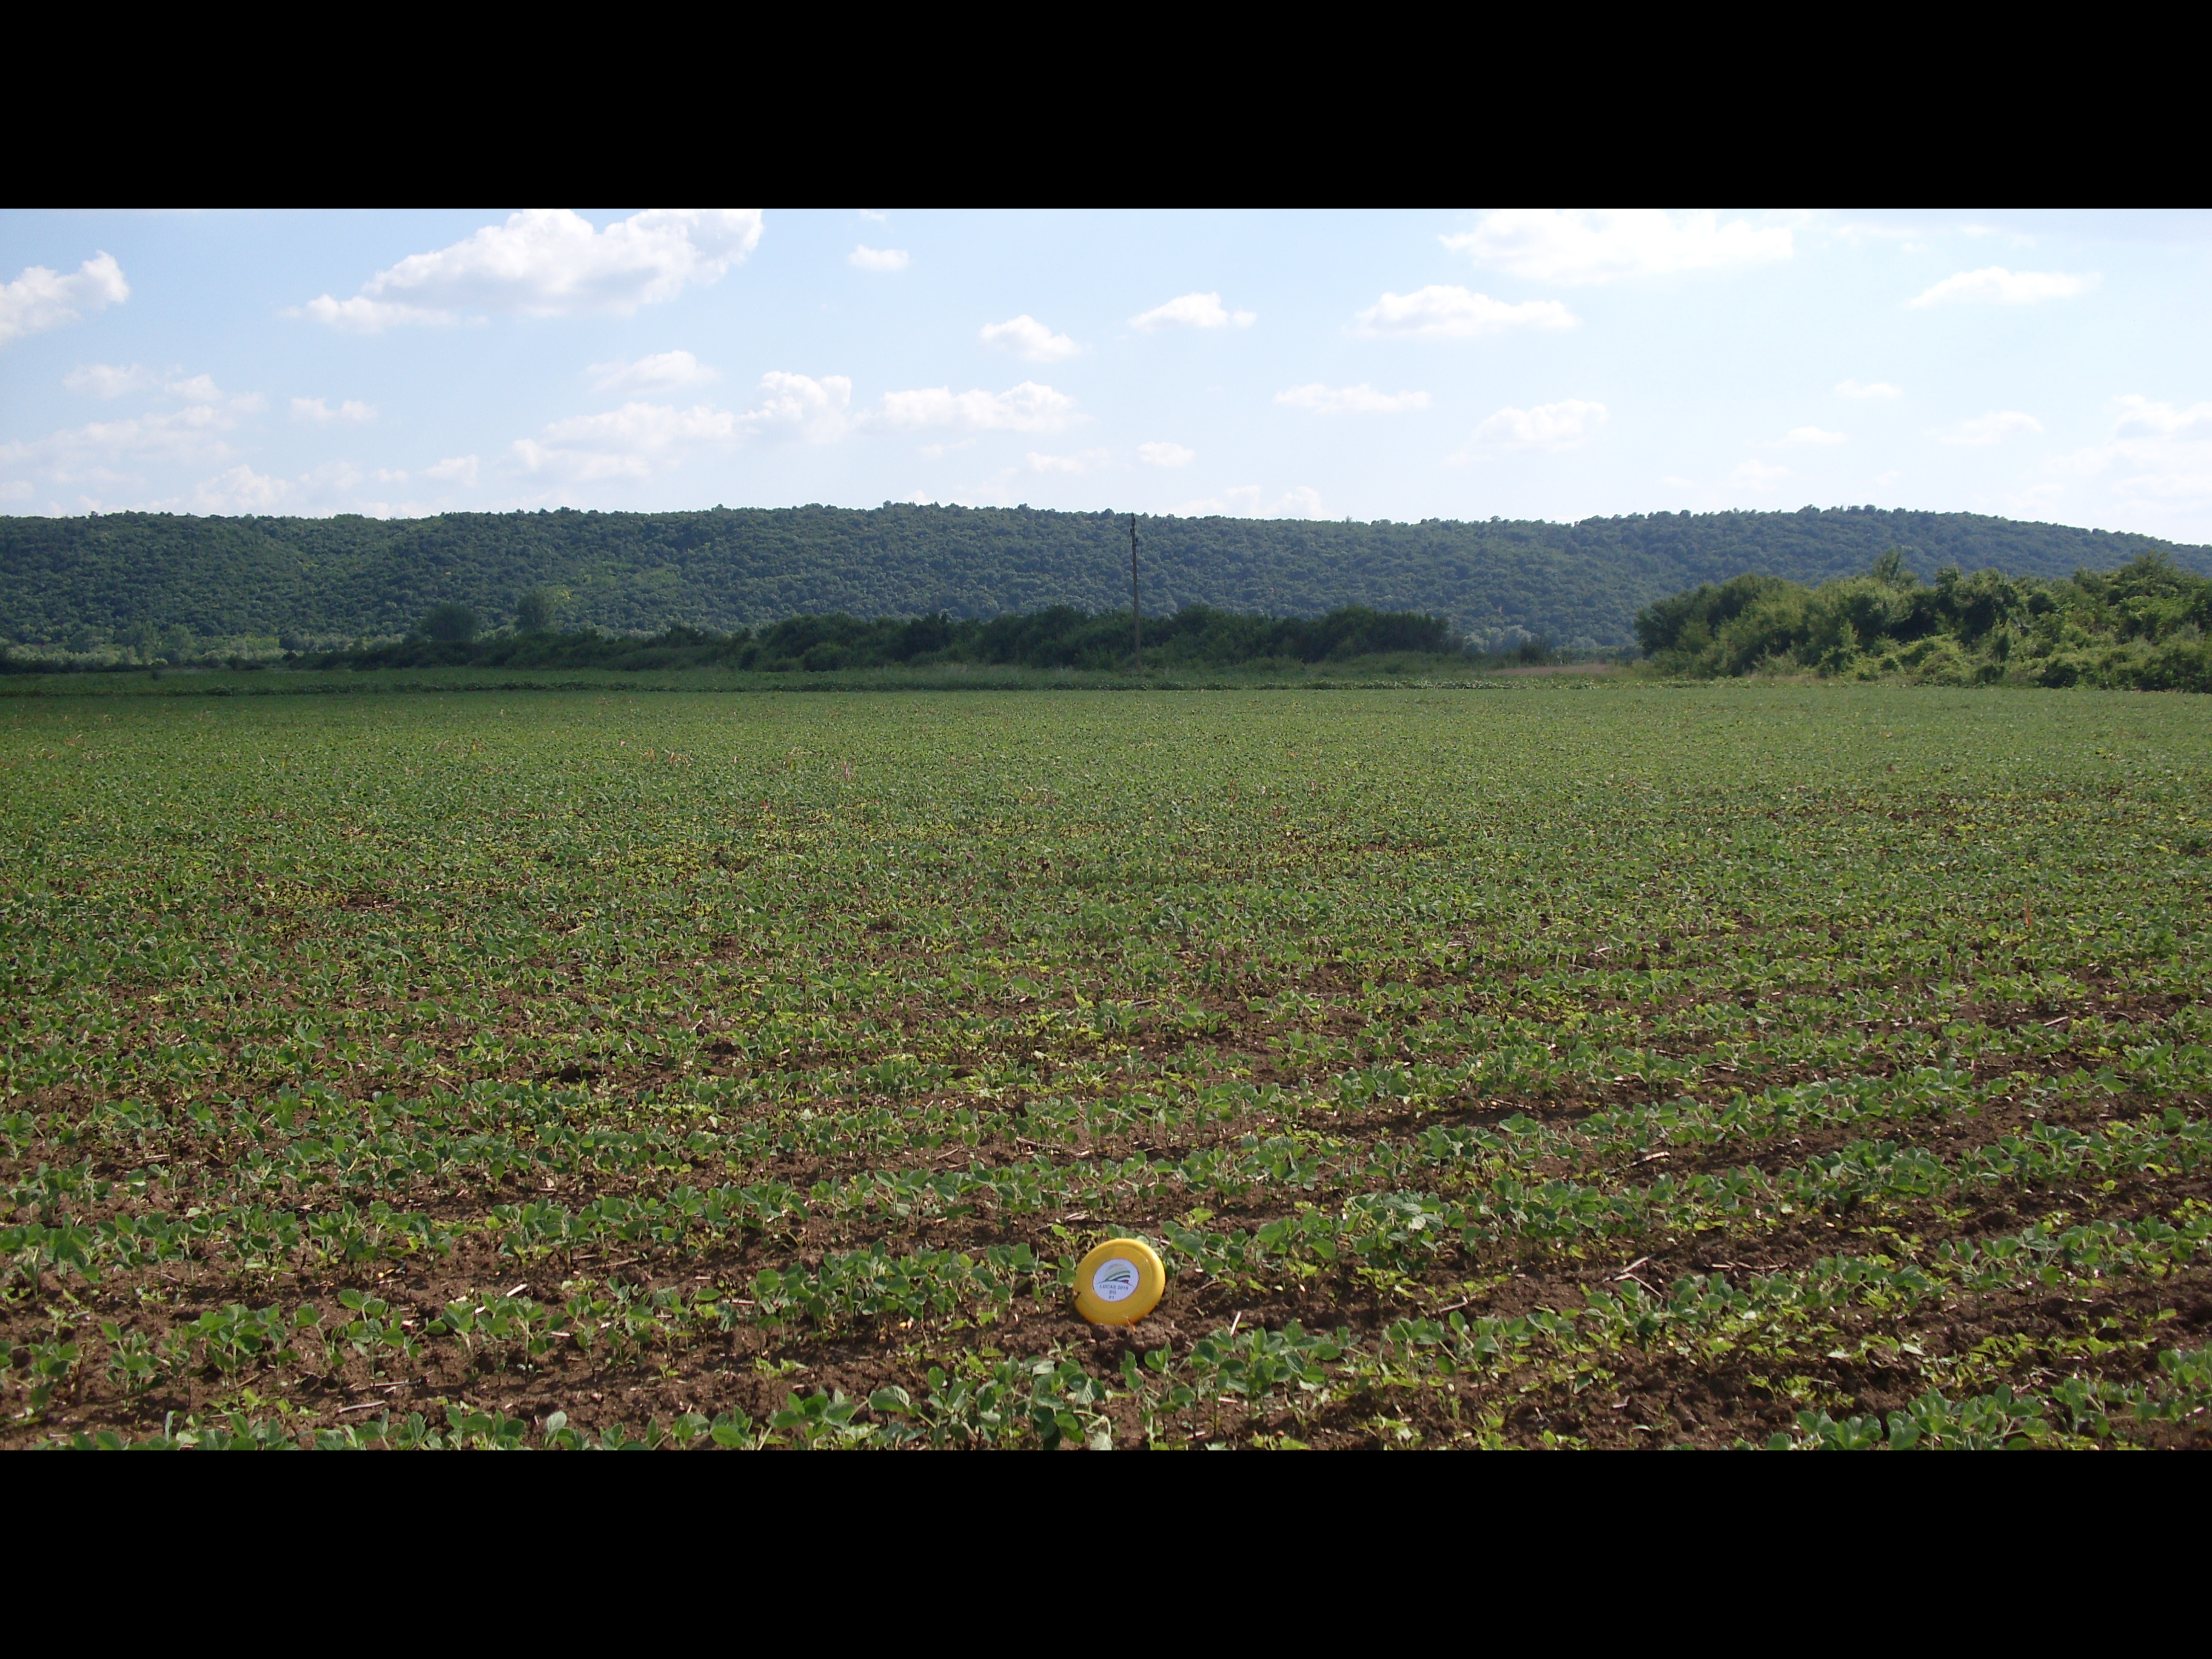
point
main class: Cropland
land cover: Soya
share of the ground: 50 - 75 %
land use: Agriculture (excluding fallow land and kitchen gardens)
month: June
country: BG
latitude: 43.5228
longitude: 23.4681
